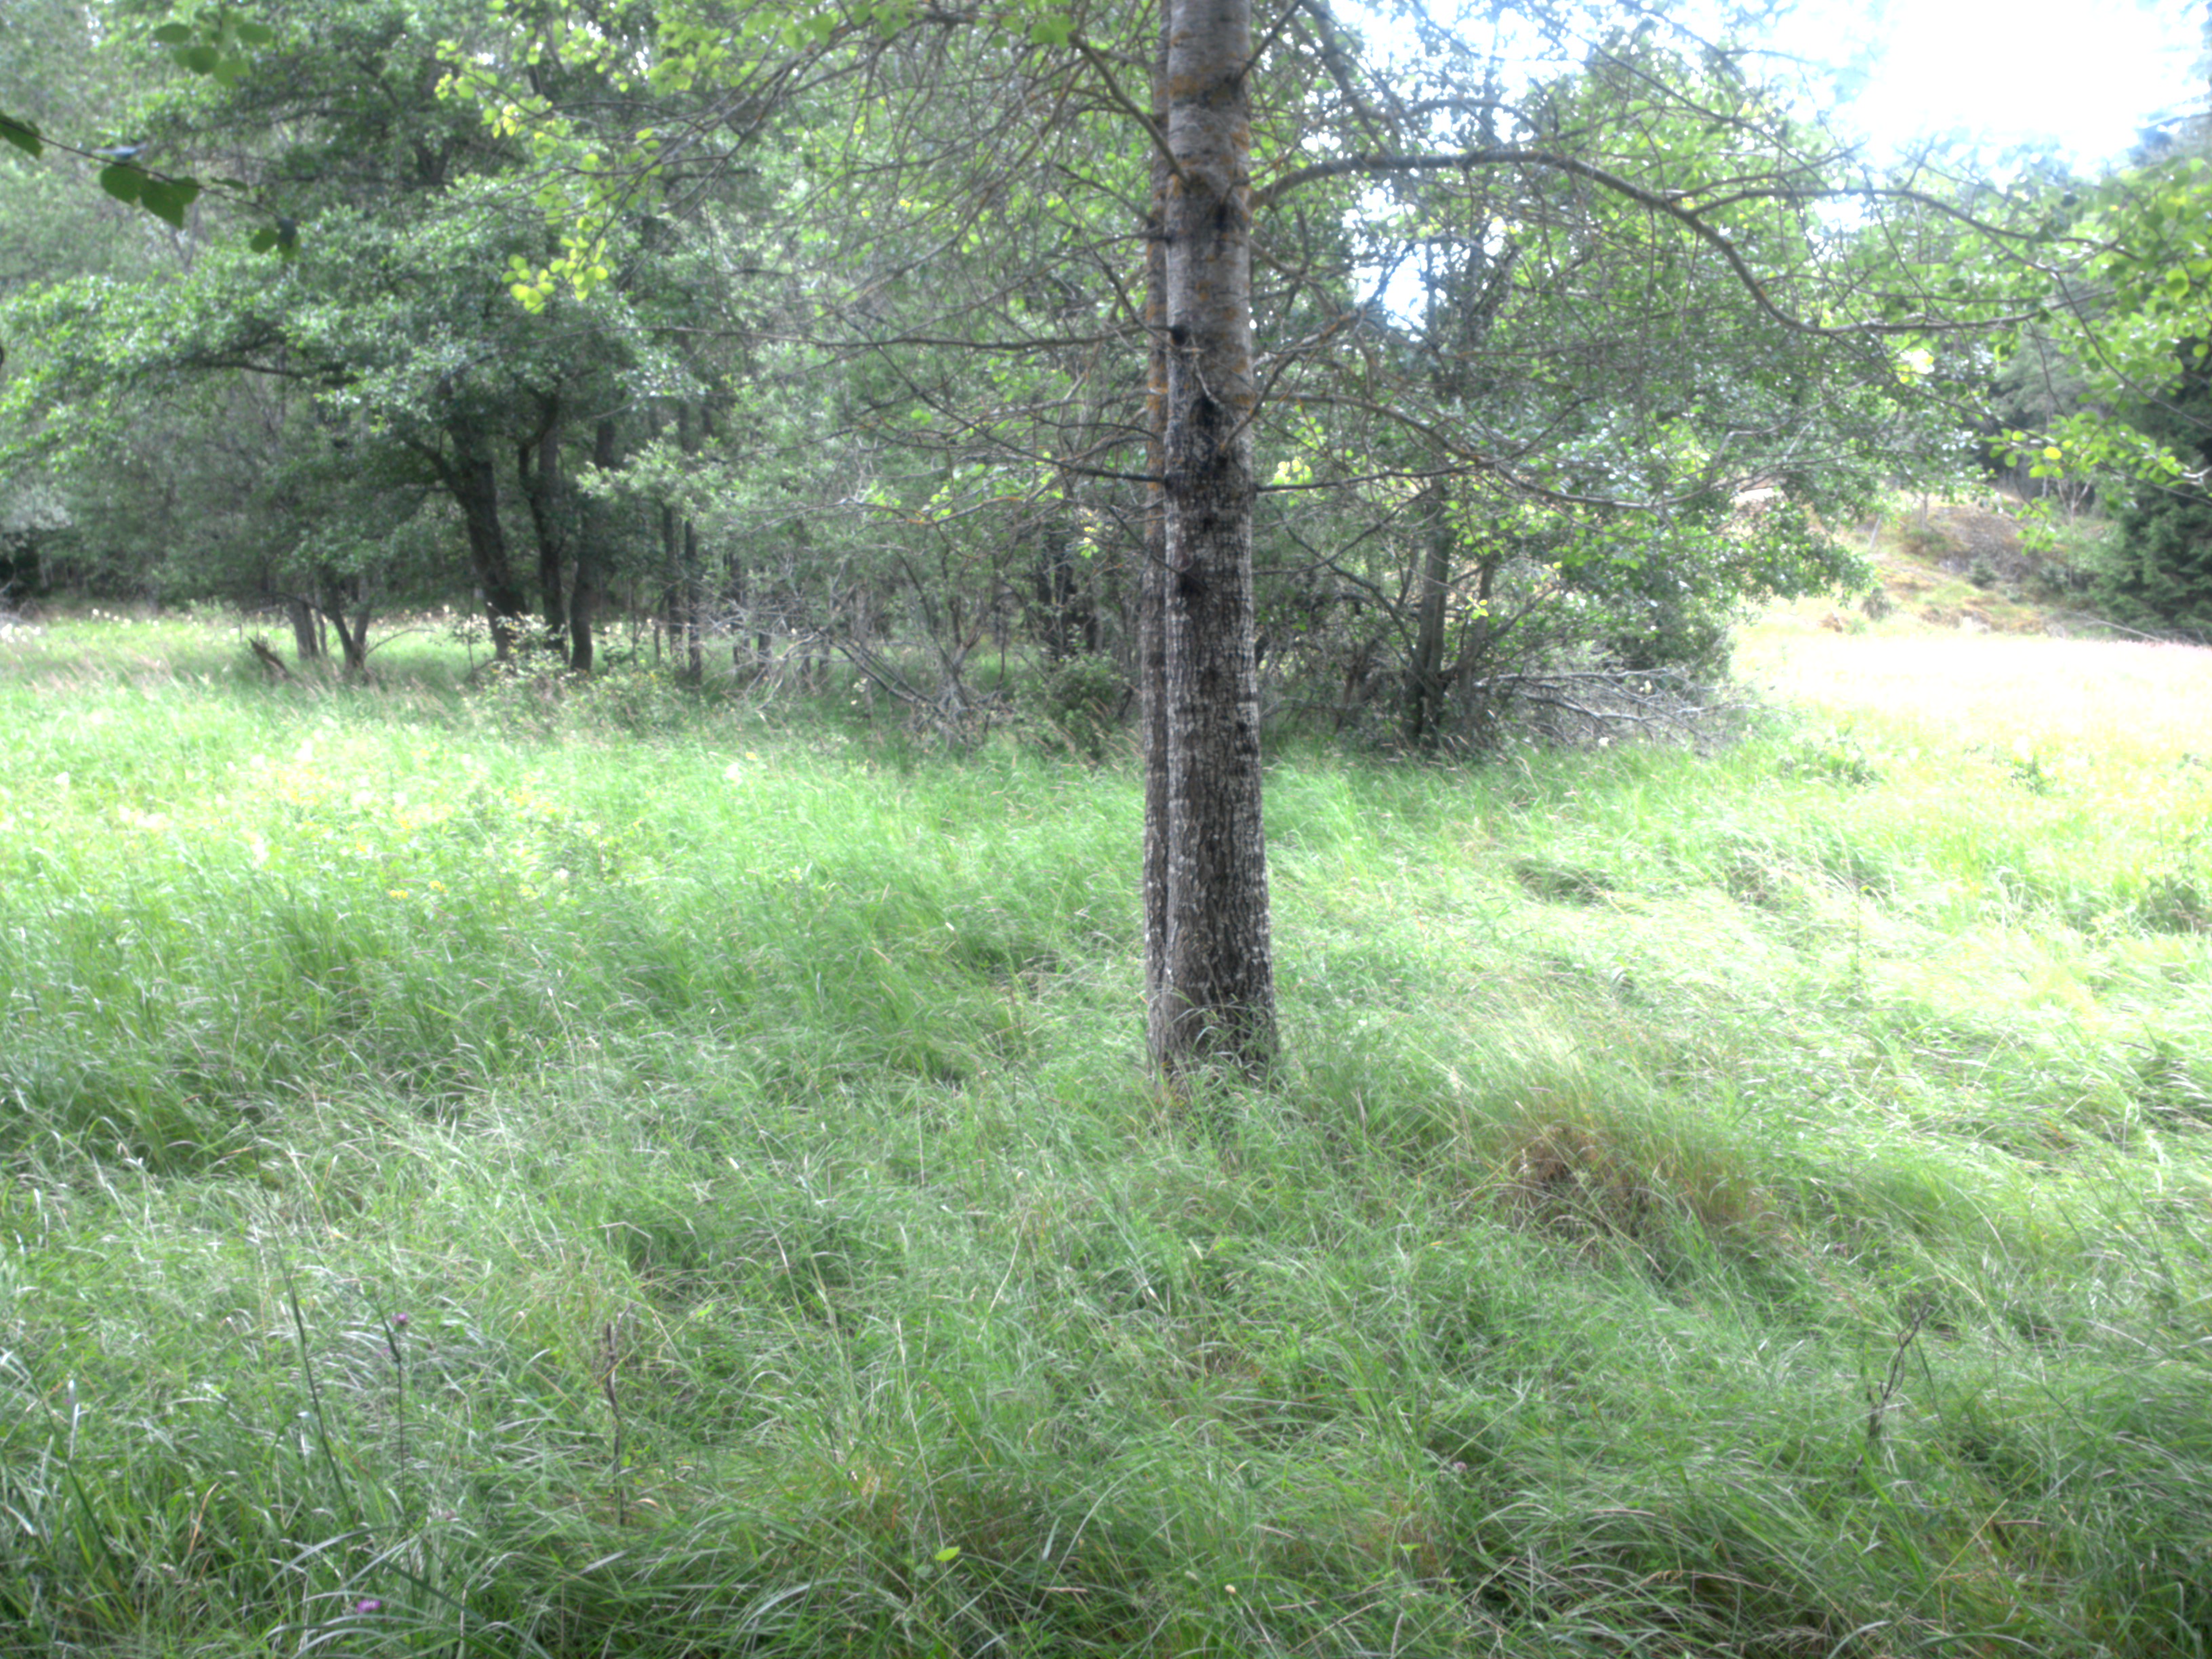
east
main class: Woodland
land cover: Broadleaved woodland
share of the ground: > 75 %
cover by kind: broadleaved forest trees 90 %, herbaceous plants 5 %, lichens and mosses 5 %
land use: Amenities, museums, leisure
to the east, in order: Broadleaved woodland; Tracks; Ditches and canals; Spruce dominated mixed woodland; Broadleaved woodland; Ditches and canals; Broadleaved woodland; Ditches and canals; Paved roads, cycling and walking lanes
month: July
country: SE
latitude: 59.2124
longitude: 18.2851
